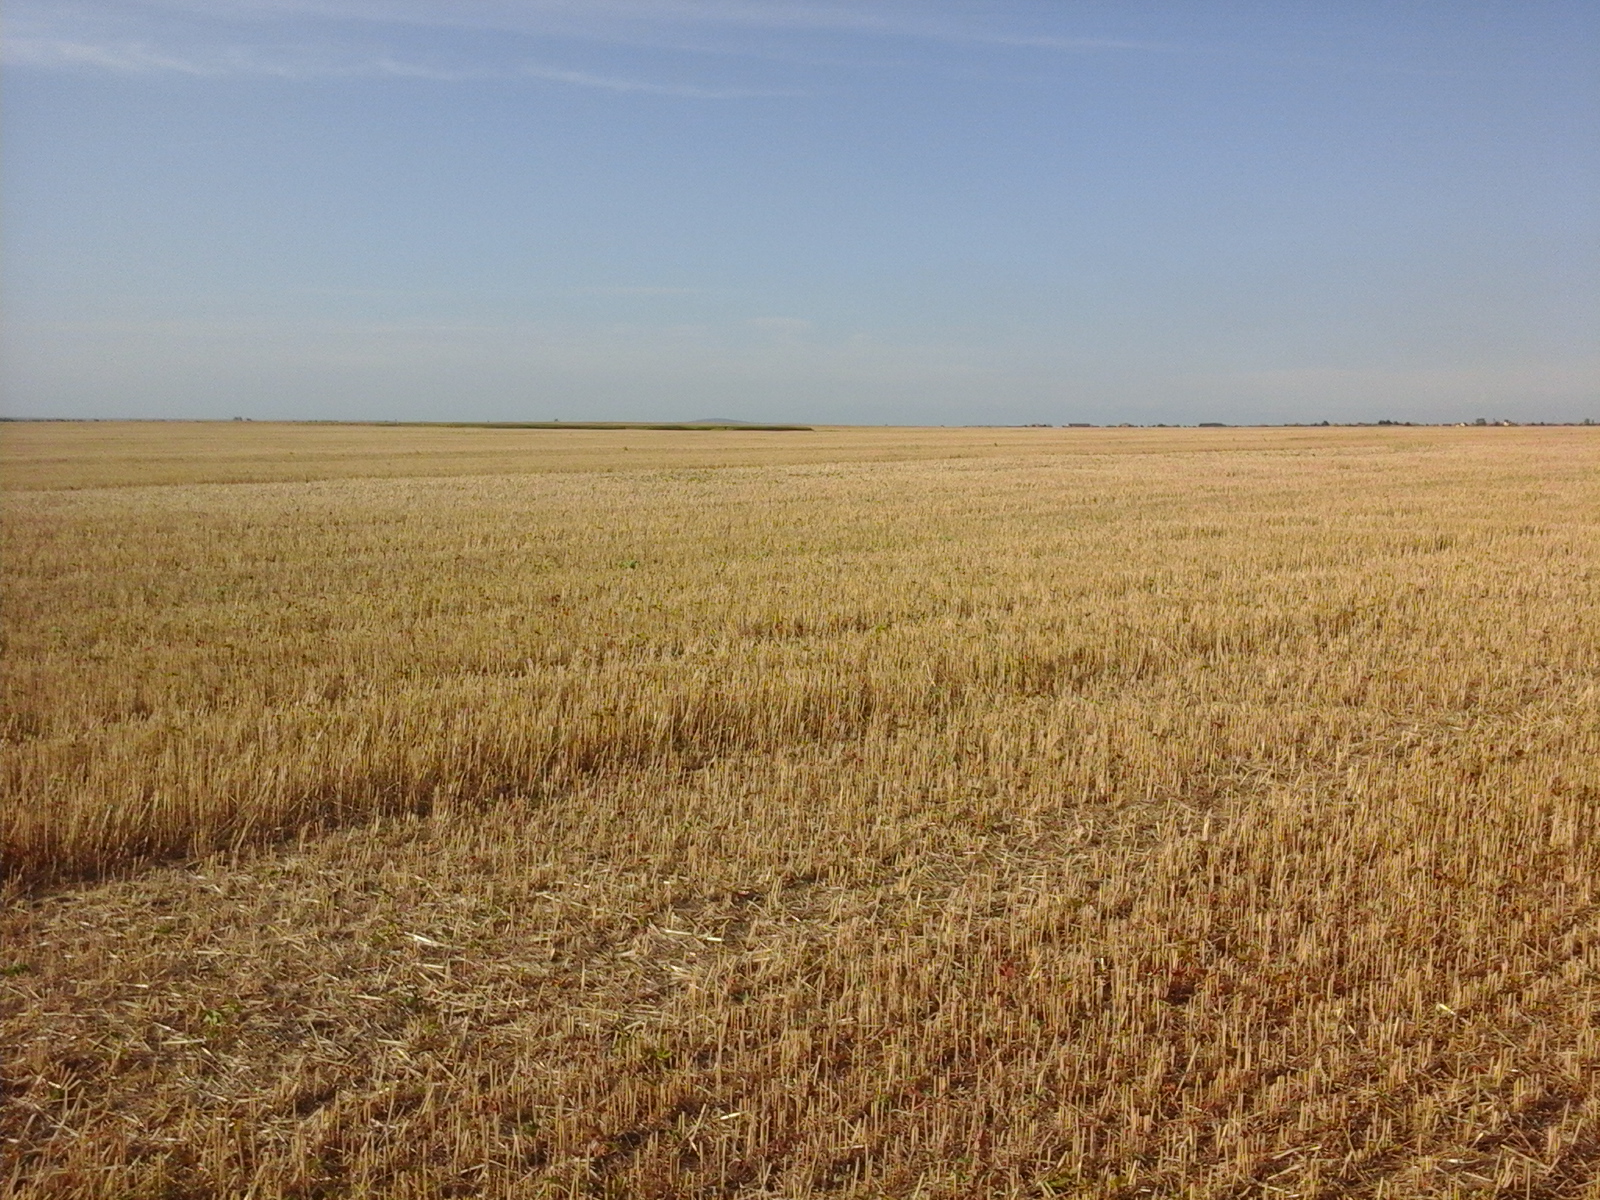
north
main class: Cropland
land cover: Common wheat
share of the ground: > 75 %
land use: Agriculture (excluding fallow land and kitchen gardens)
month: August
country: RO
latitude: 45.2327
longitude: 21.3784
